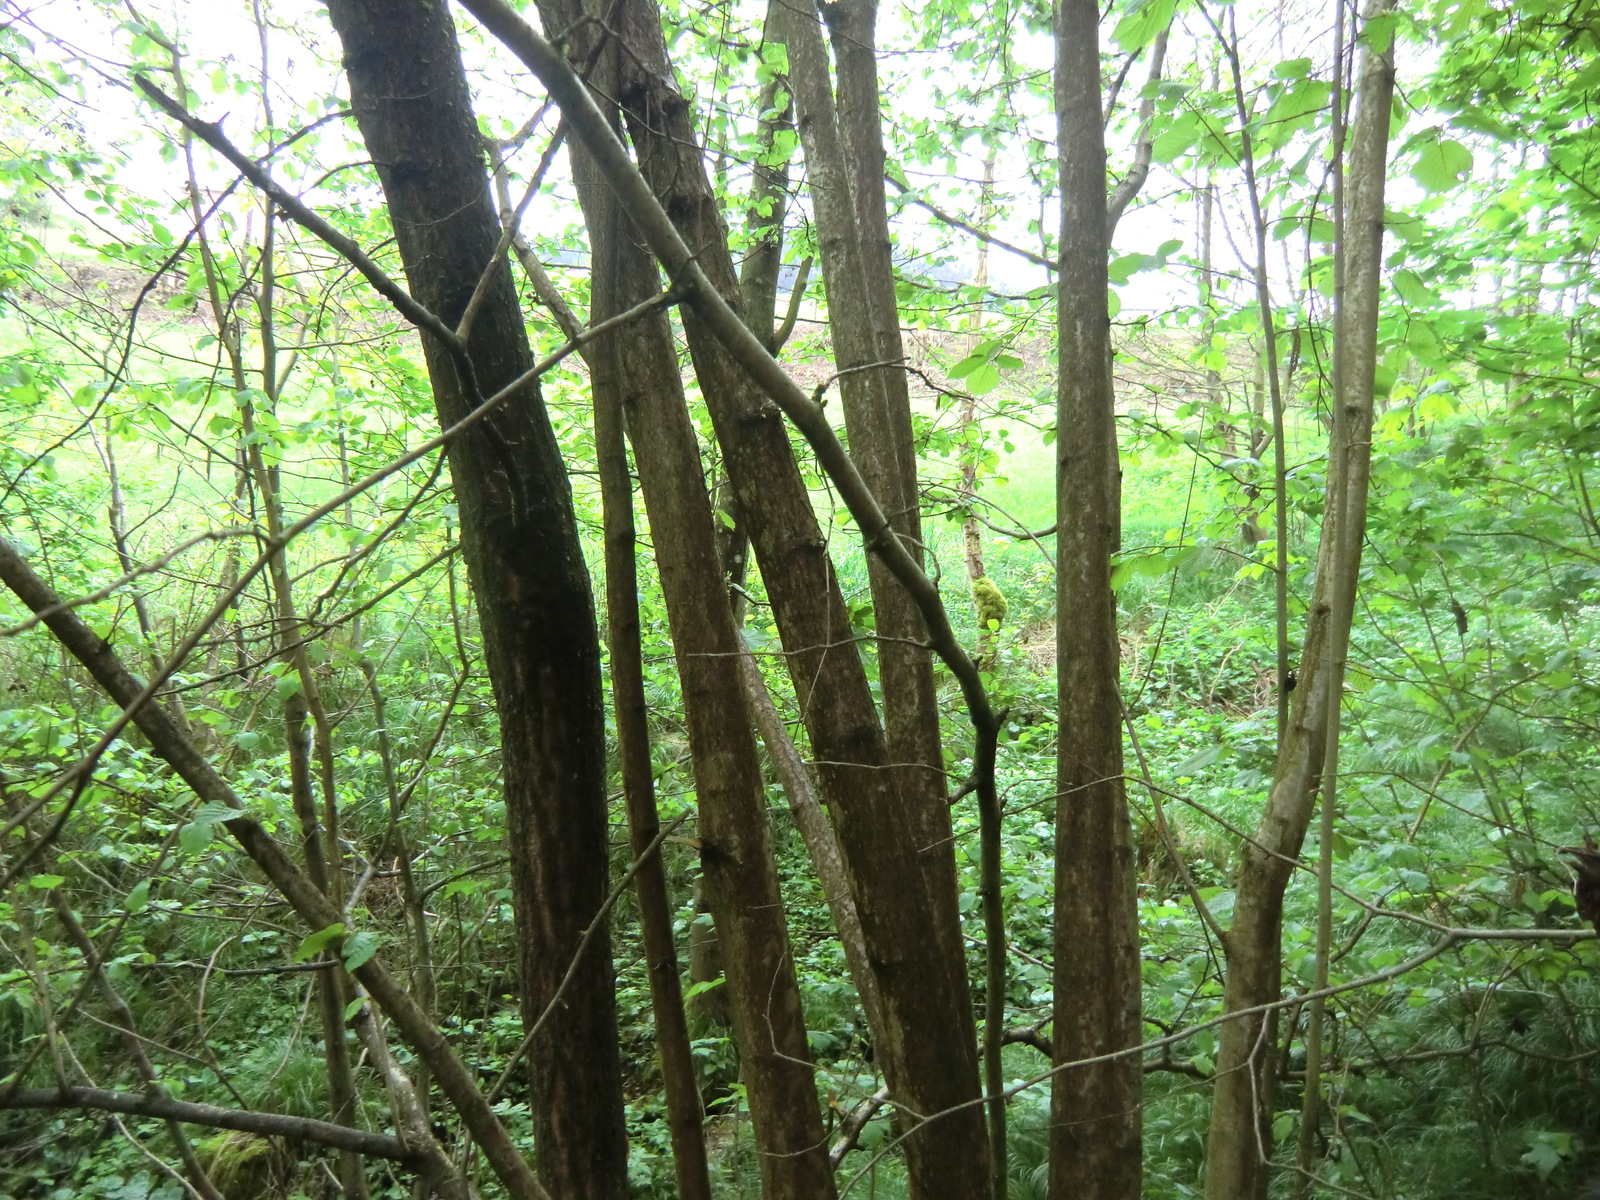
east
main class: Woodland
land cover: Broadleaved woodland
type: hemiboreal forest and nemoral coniferous forest and mixed broadleaved-coniferous forest
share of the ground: > 75 %
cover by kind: broadleaved forest trees 55 %, herbaceous plants 30 %, unconsolidated bare surface 10 %, coniferous forest trees 5 %
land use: Forestry
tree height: > 5 m
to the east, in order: Broadleaved woodland; Rivers and streams; Broadleaved woodland; Grassland without tree/shrub cover; Abandoned hedges; Grassland without tree/shrub cover; Tracks; Grassland without tree/shrub cover; Artificial constructions in urban areas
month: May
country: AT
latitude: 48.3213
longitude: 14.7075
